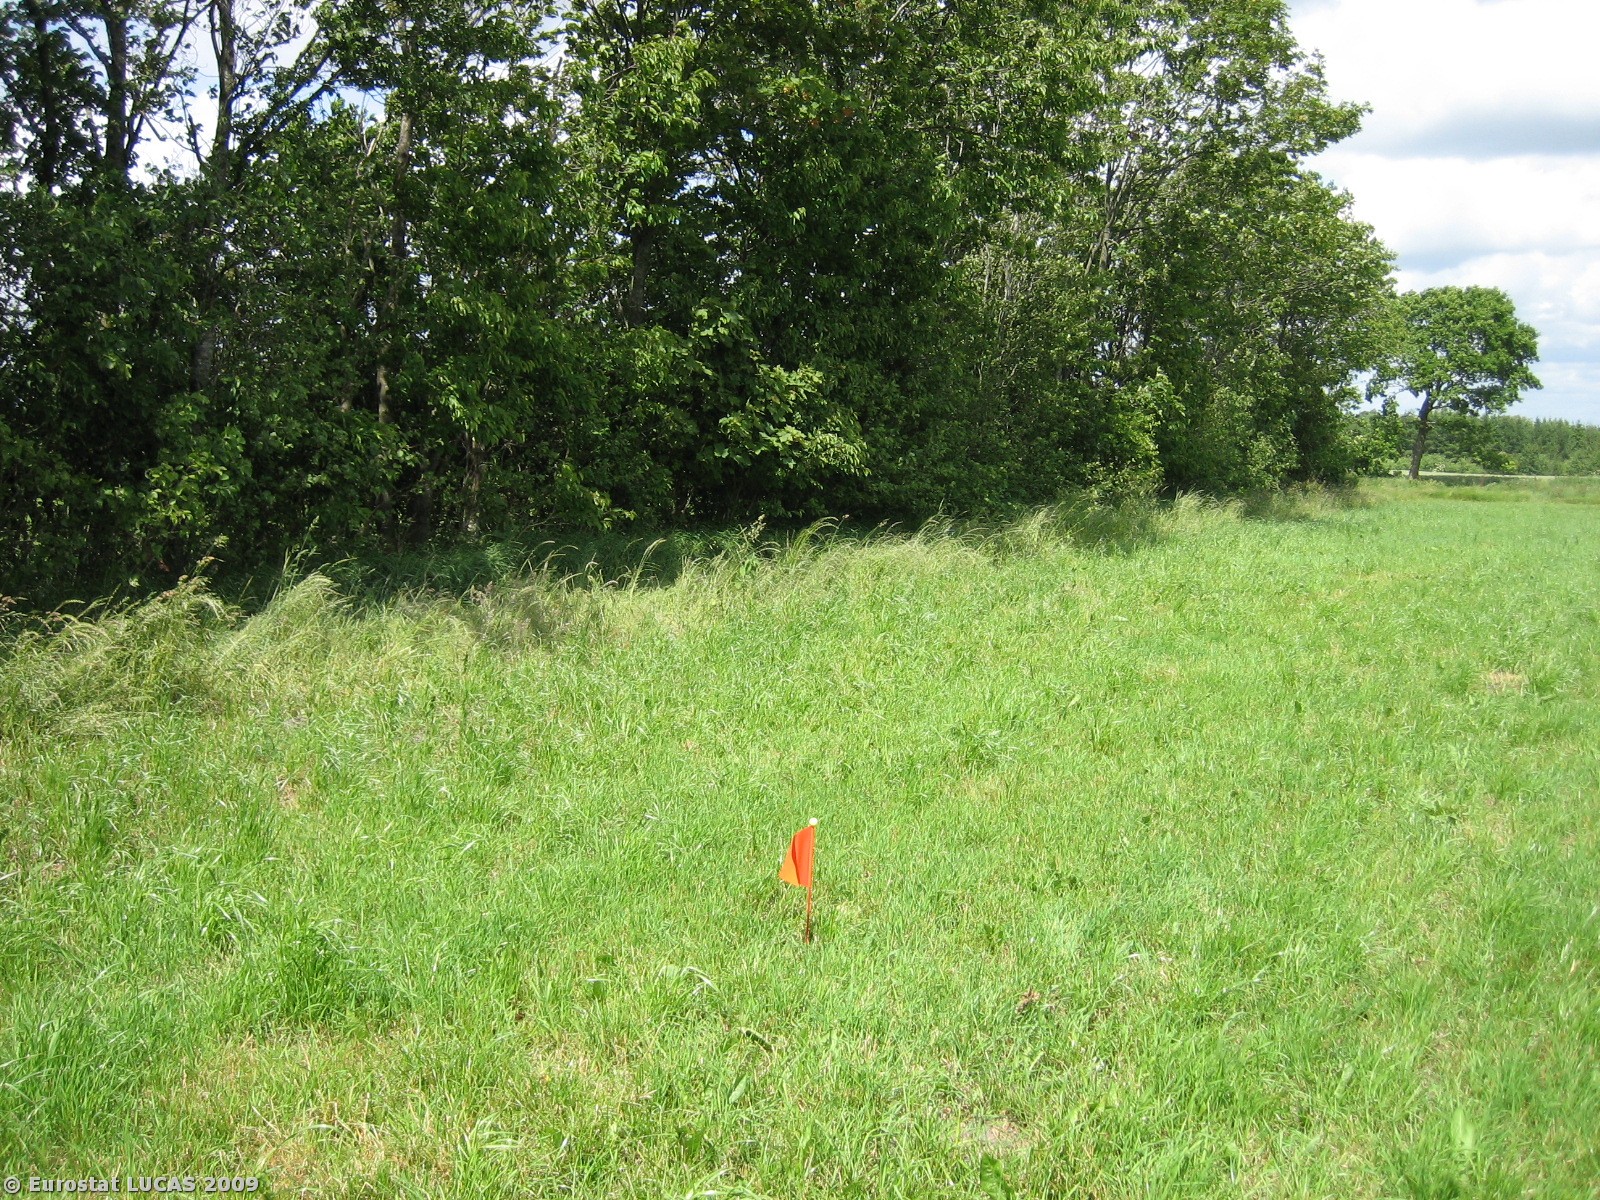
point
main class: Cropland
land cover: Temporary grasslands
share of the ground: > 75 %
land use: Agriculture (excluding fallow land and kitchen gardens)
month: June
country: DK
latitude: 55.7719
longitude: 9.2197
